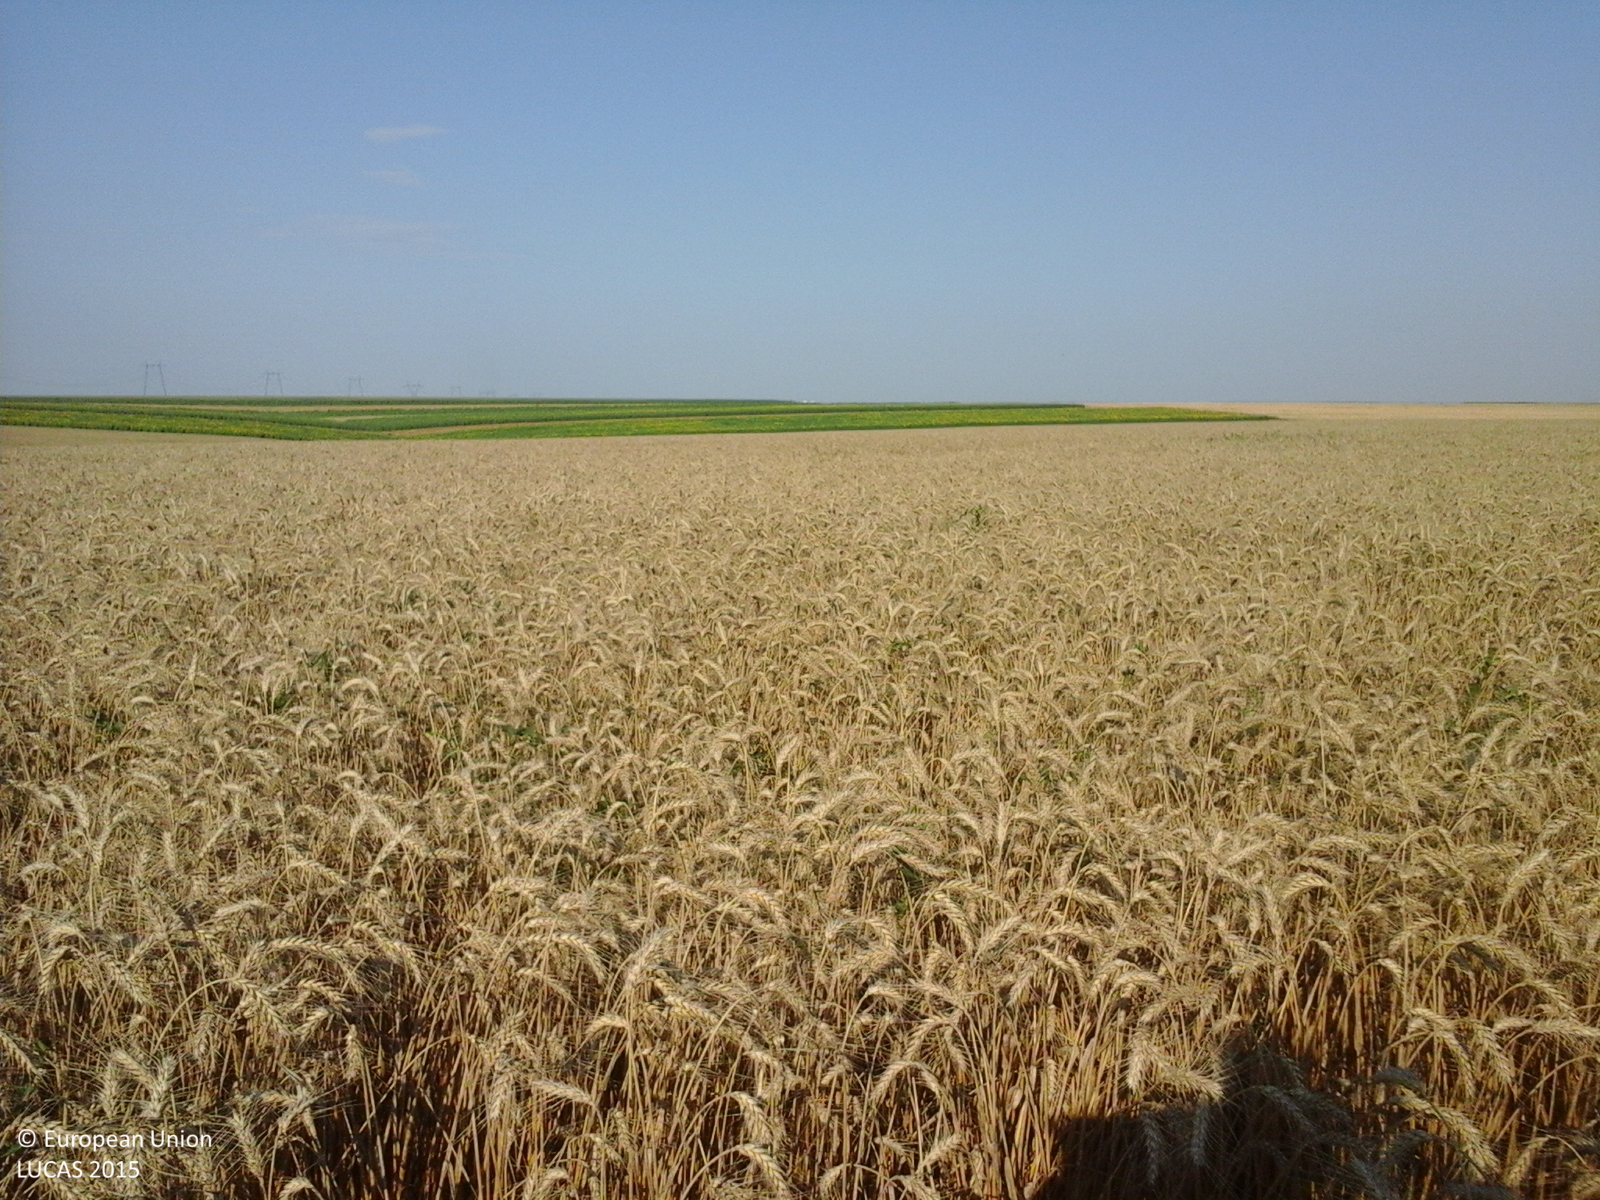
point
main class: Cropland
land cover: Common wheat
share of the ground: > 75 %
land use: Agriculture (excluding fallow land and kitchen gardens)
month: July
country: RO
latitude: 44.3107
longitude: 24.6522
